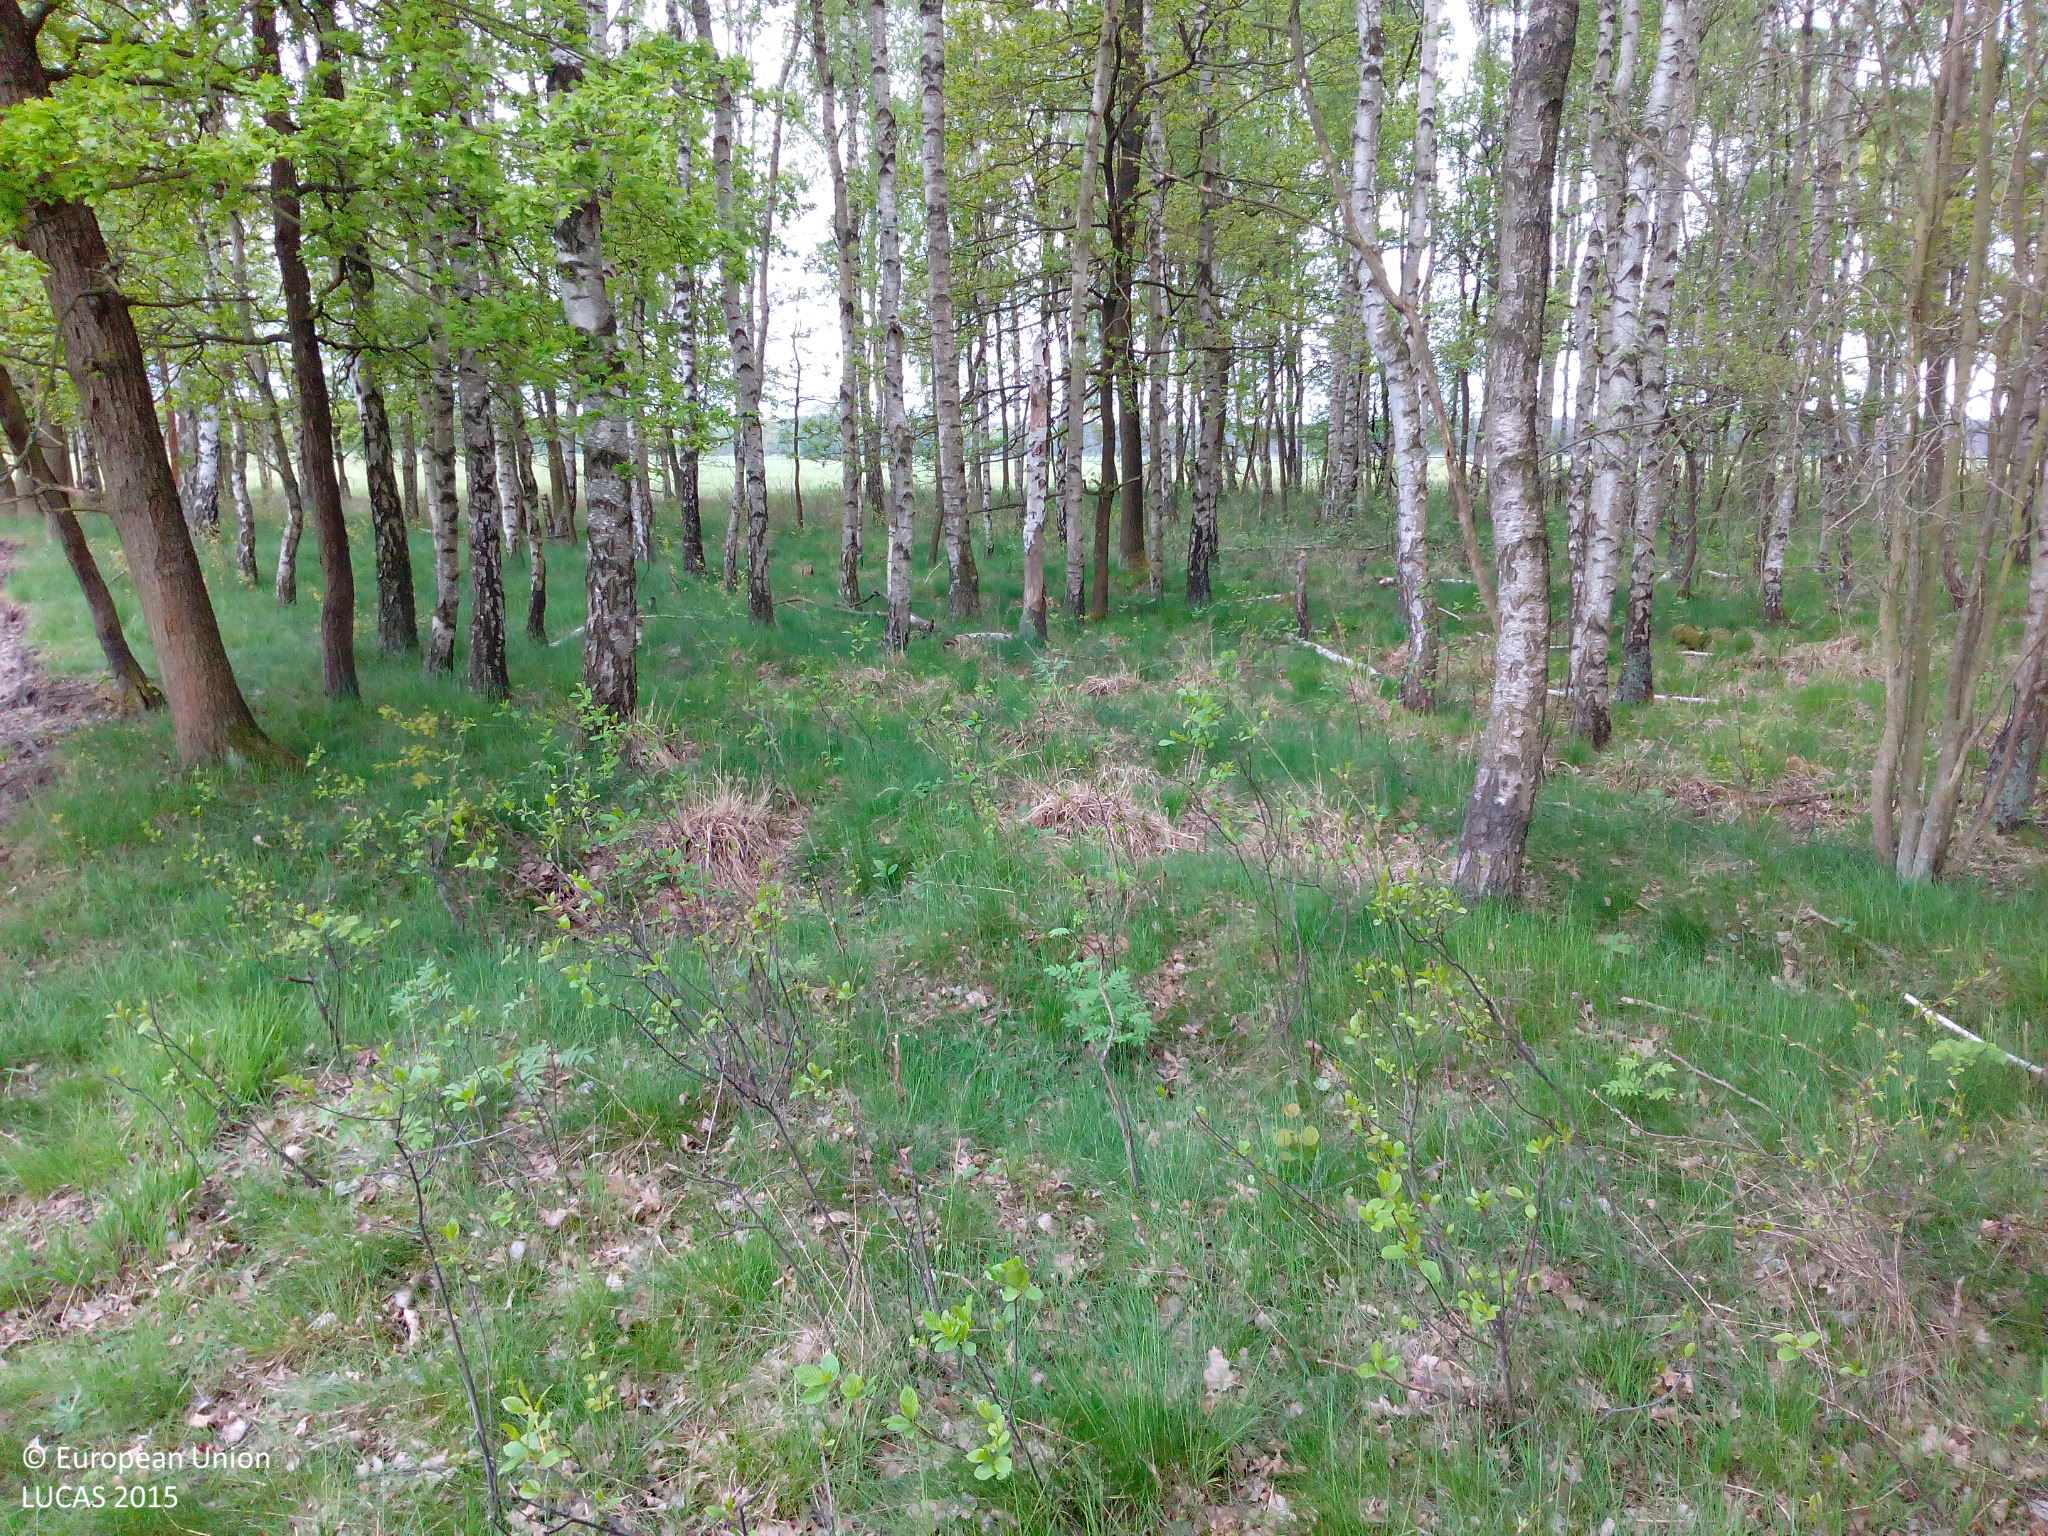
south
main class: Woodland
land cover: Broadleaved woodland
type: non-riverine alder, birch or aspen forest
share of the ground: 50 - 75 %
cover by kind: broadleaved forest trees 70 %, herbaceous plants 30 %
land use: Forestry
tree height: > 5 m
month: May
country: DE
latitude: 52.9057
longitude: 11.6201
